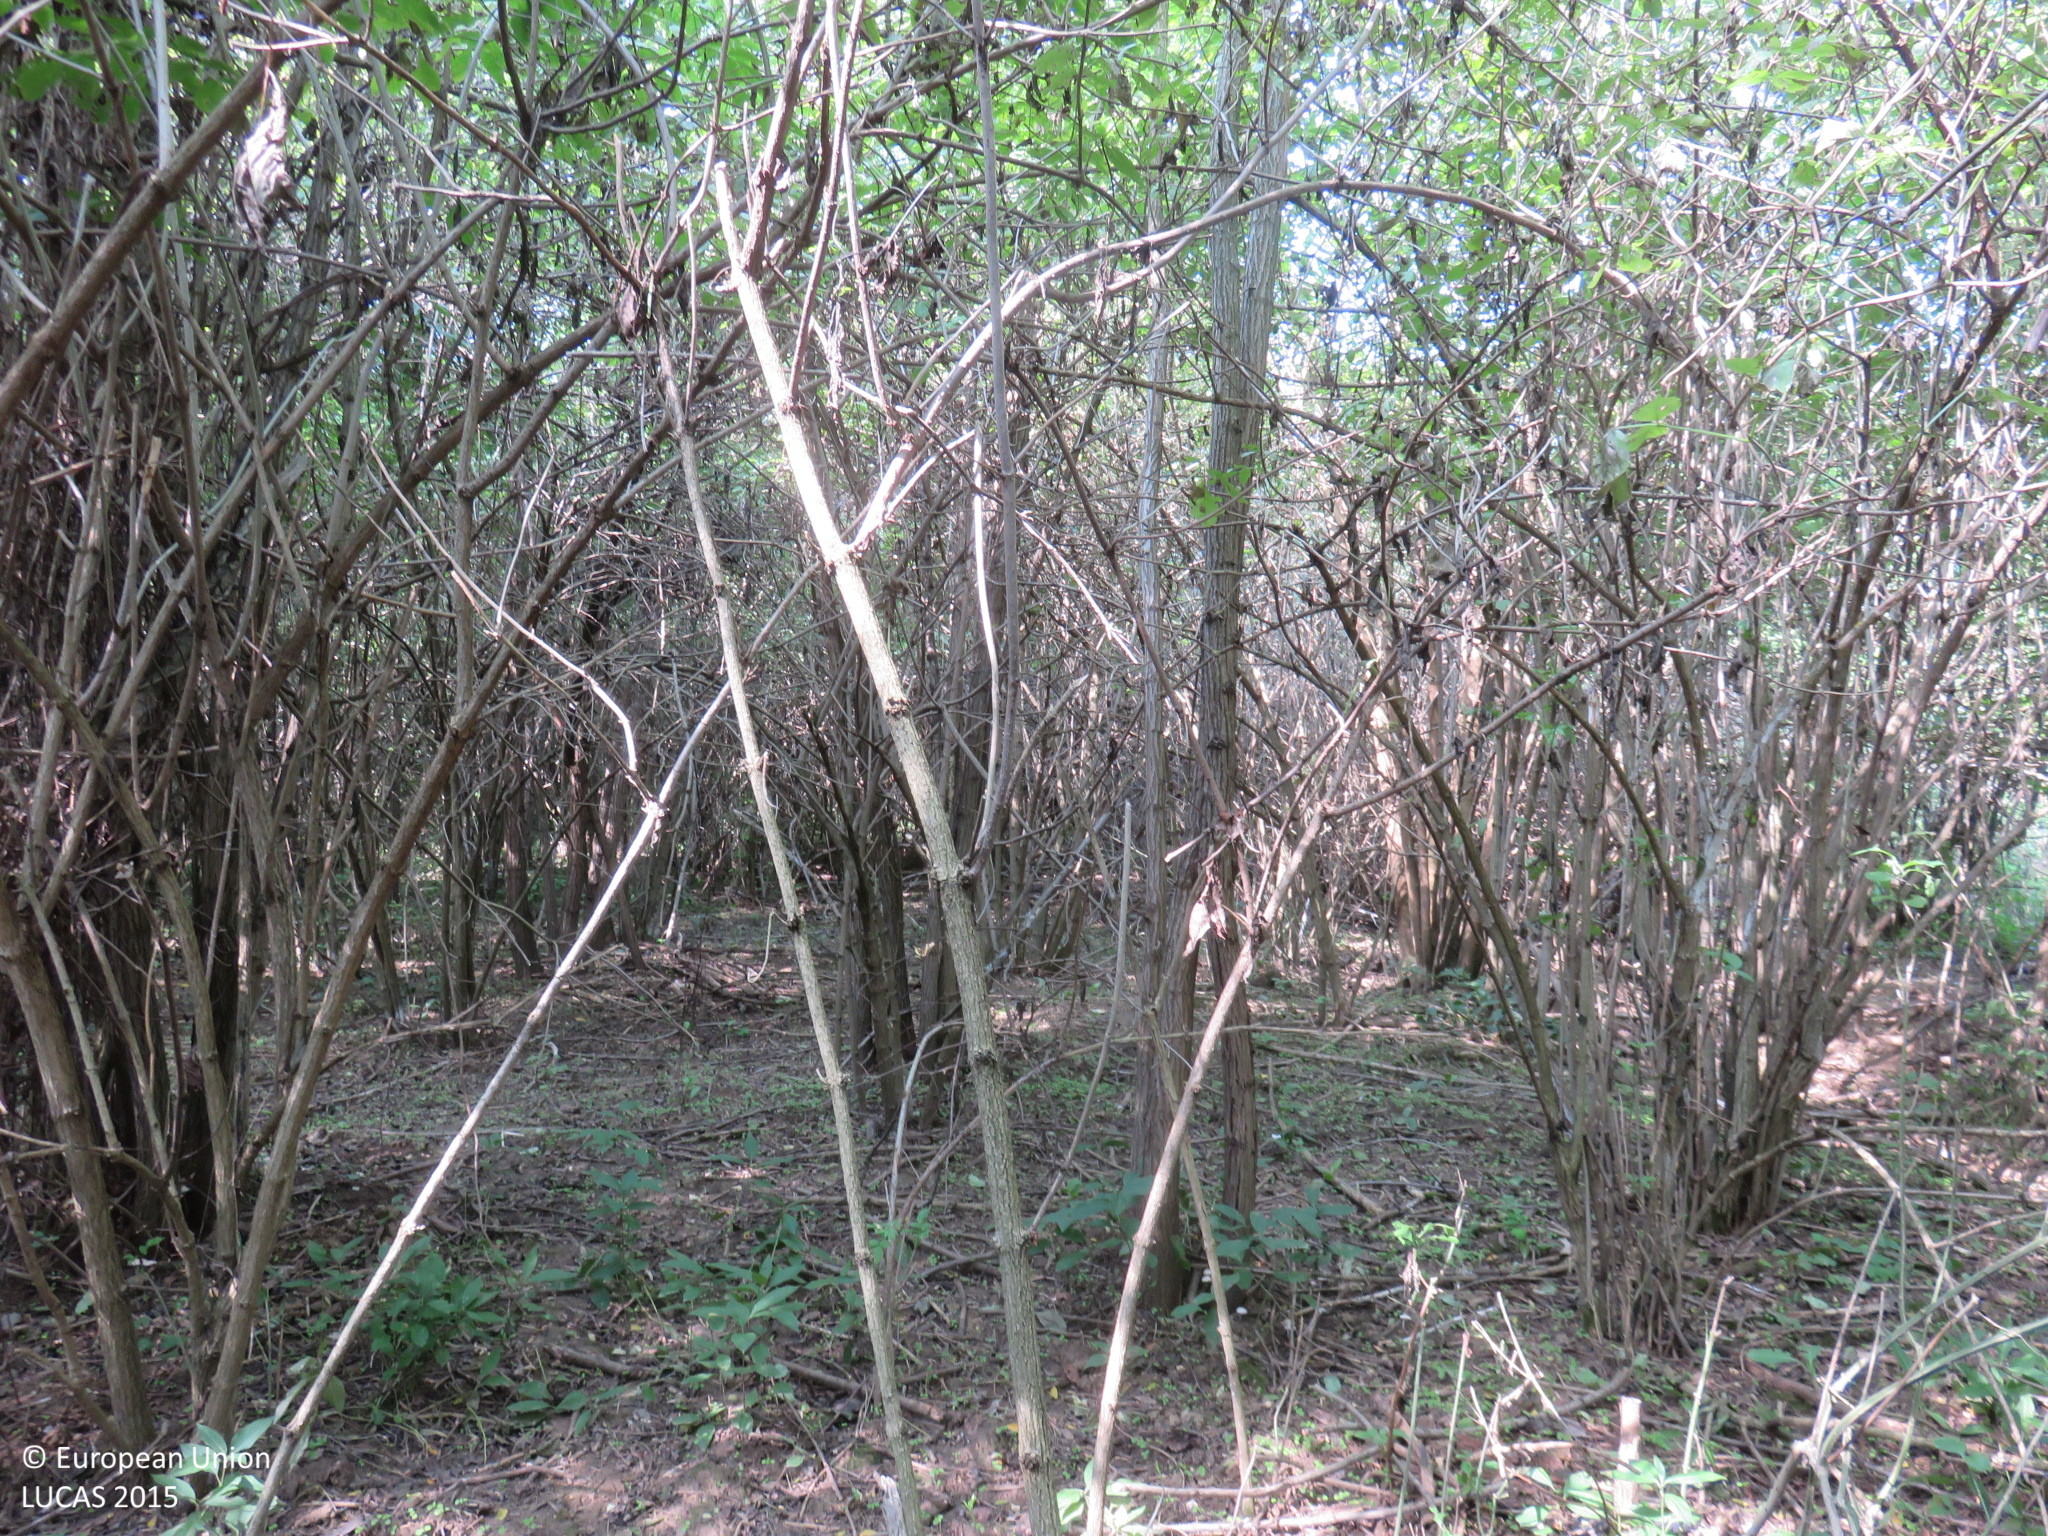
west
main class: Woodland
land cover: Broadleaved woodland
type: mesophytic deciduous forest
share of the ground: > 75 %
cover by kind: broadleaved forest trees 80 %, shrubs 20 %
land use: Semi-natural and natural areas not in use
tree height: < 5 m
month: September
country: BG
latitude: 43.6399
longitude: 24.9849
